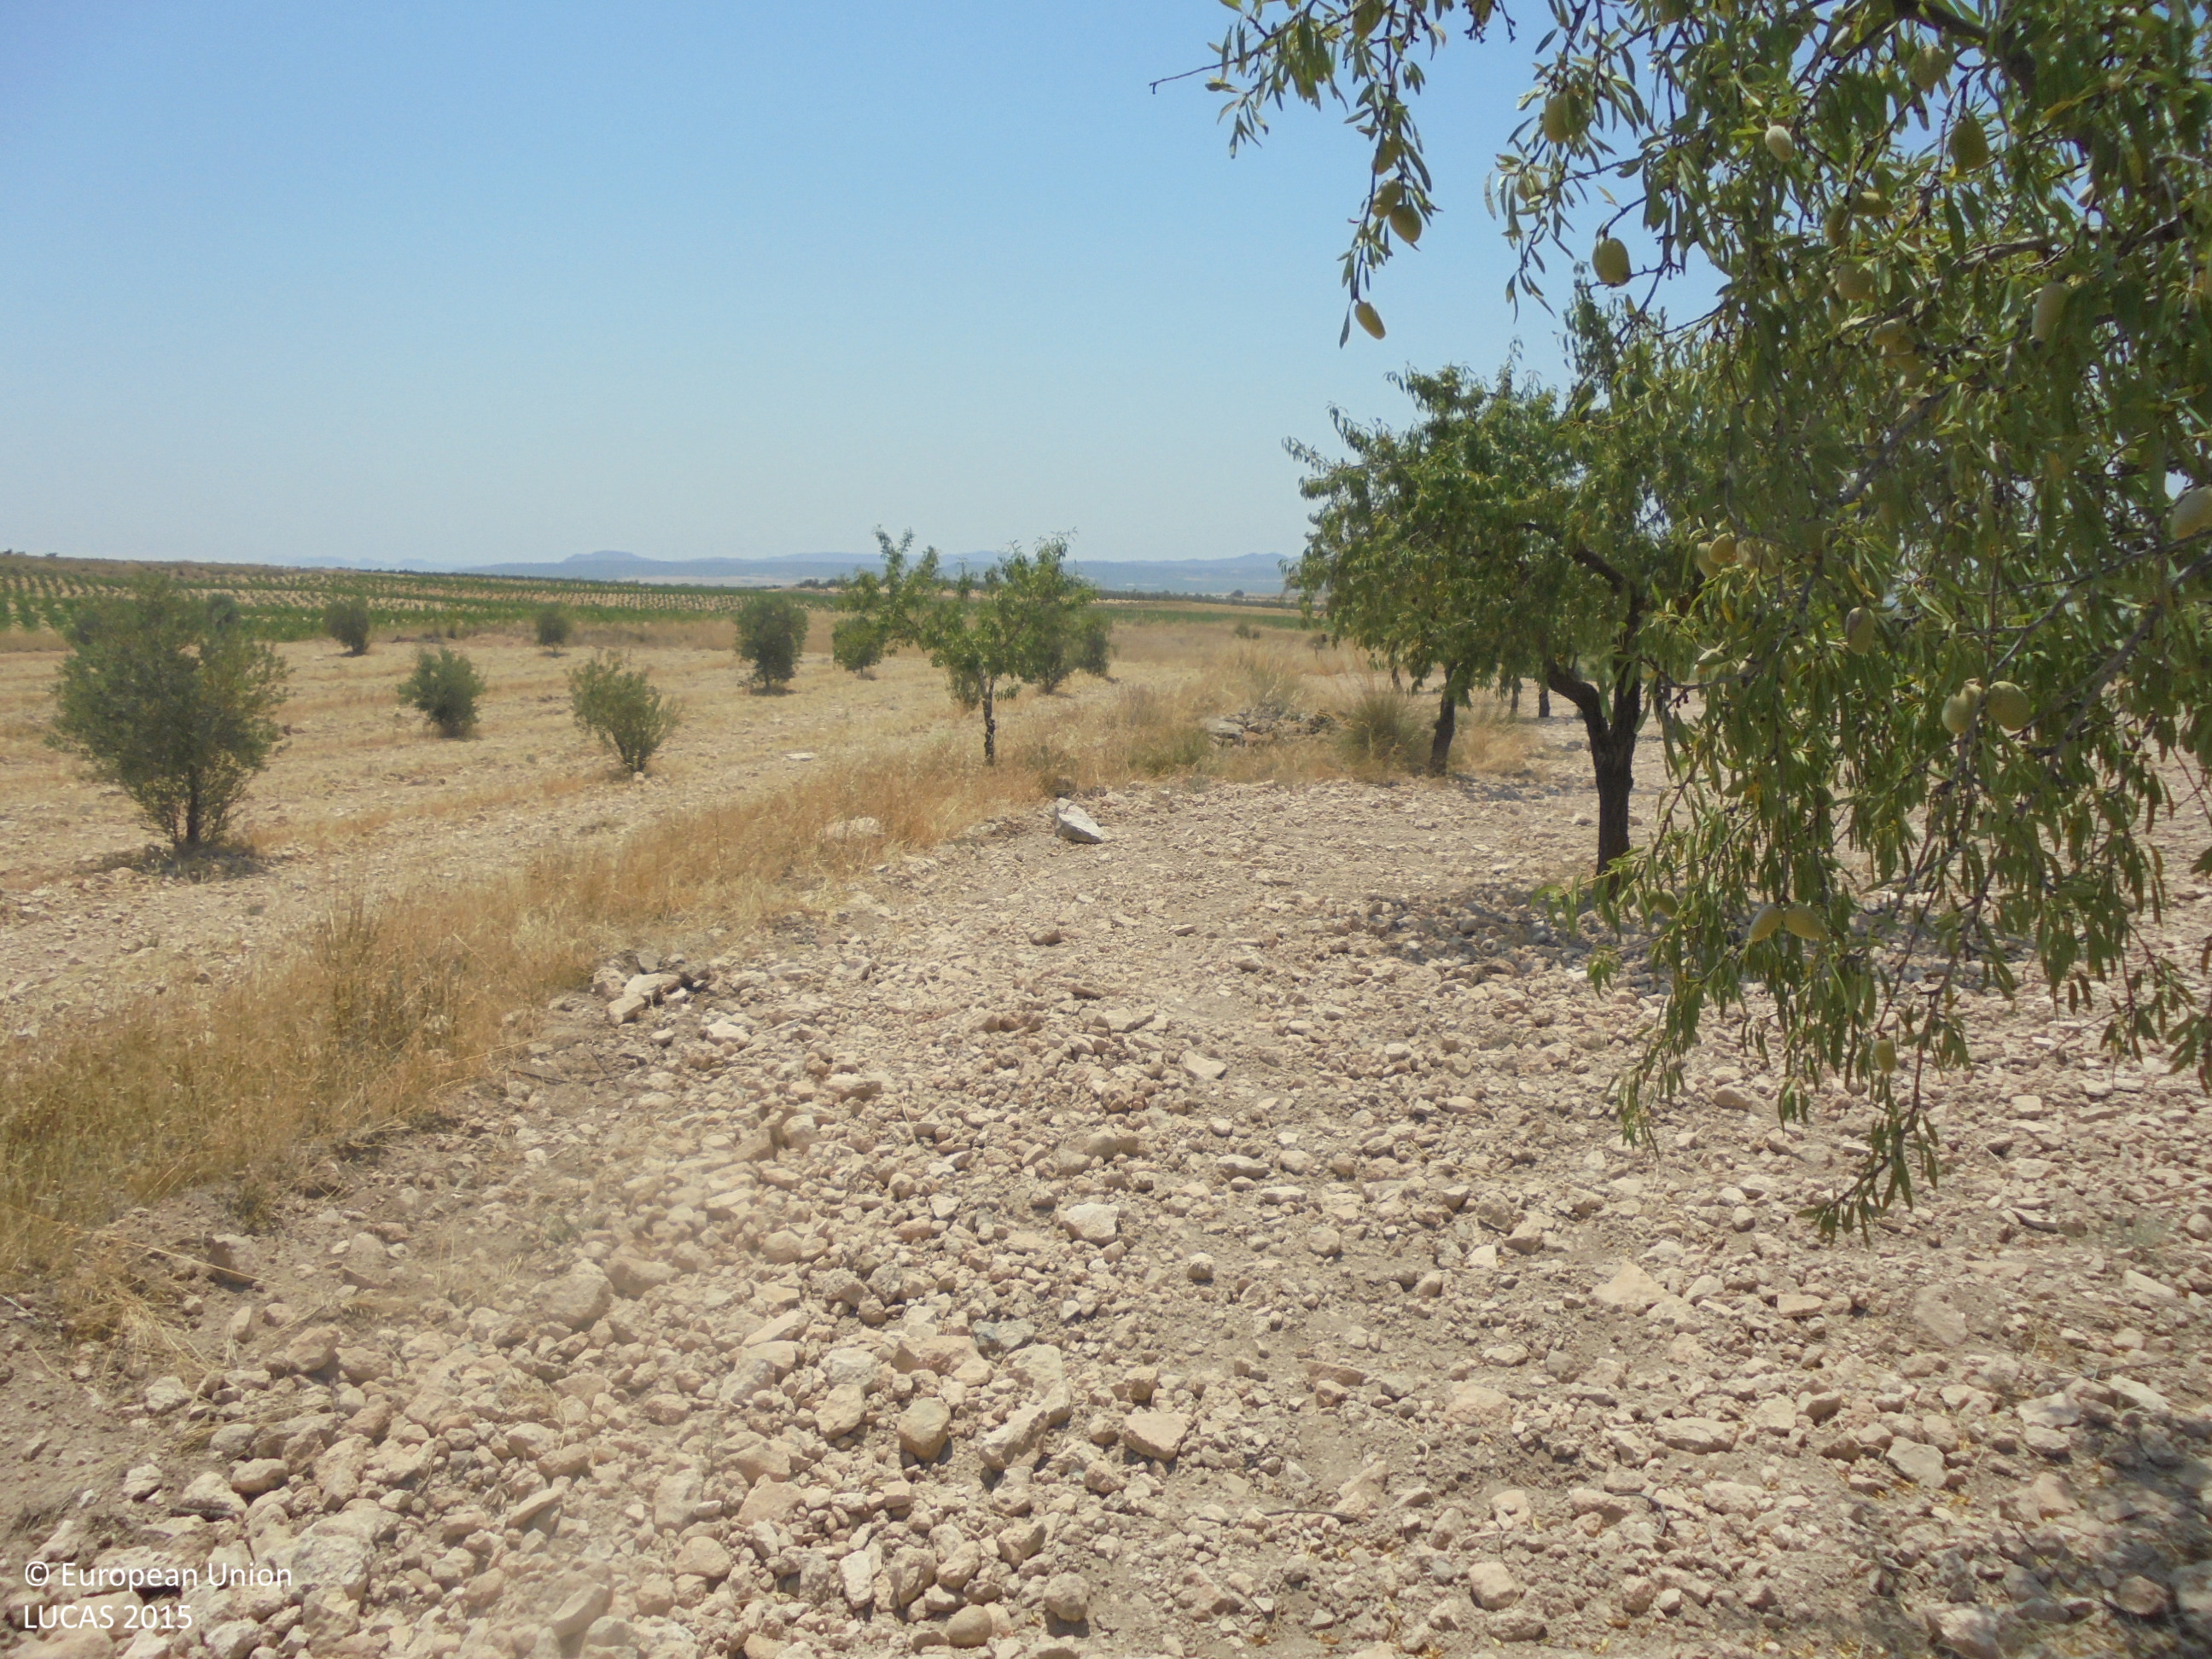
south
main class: Cropland
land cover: Nuts trees
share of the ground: 25 - 50 %
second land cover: Other bare soil
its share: > 75 %
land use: Agriculture (excluding fallow land and kitchen gardens)
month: July
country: ES
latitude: 38.6270
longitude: -1.4454
